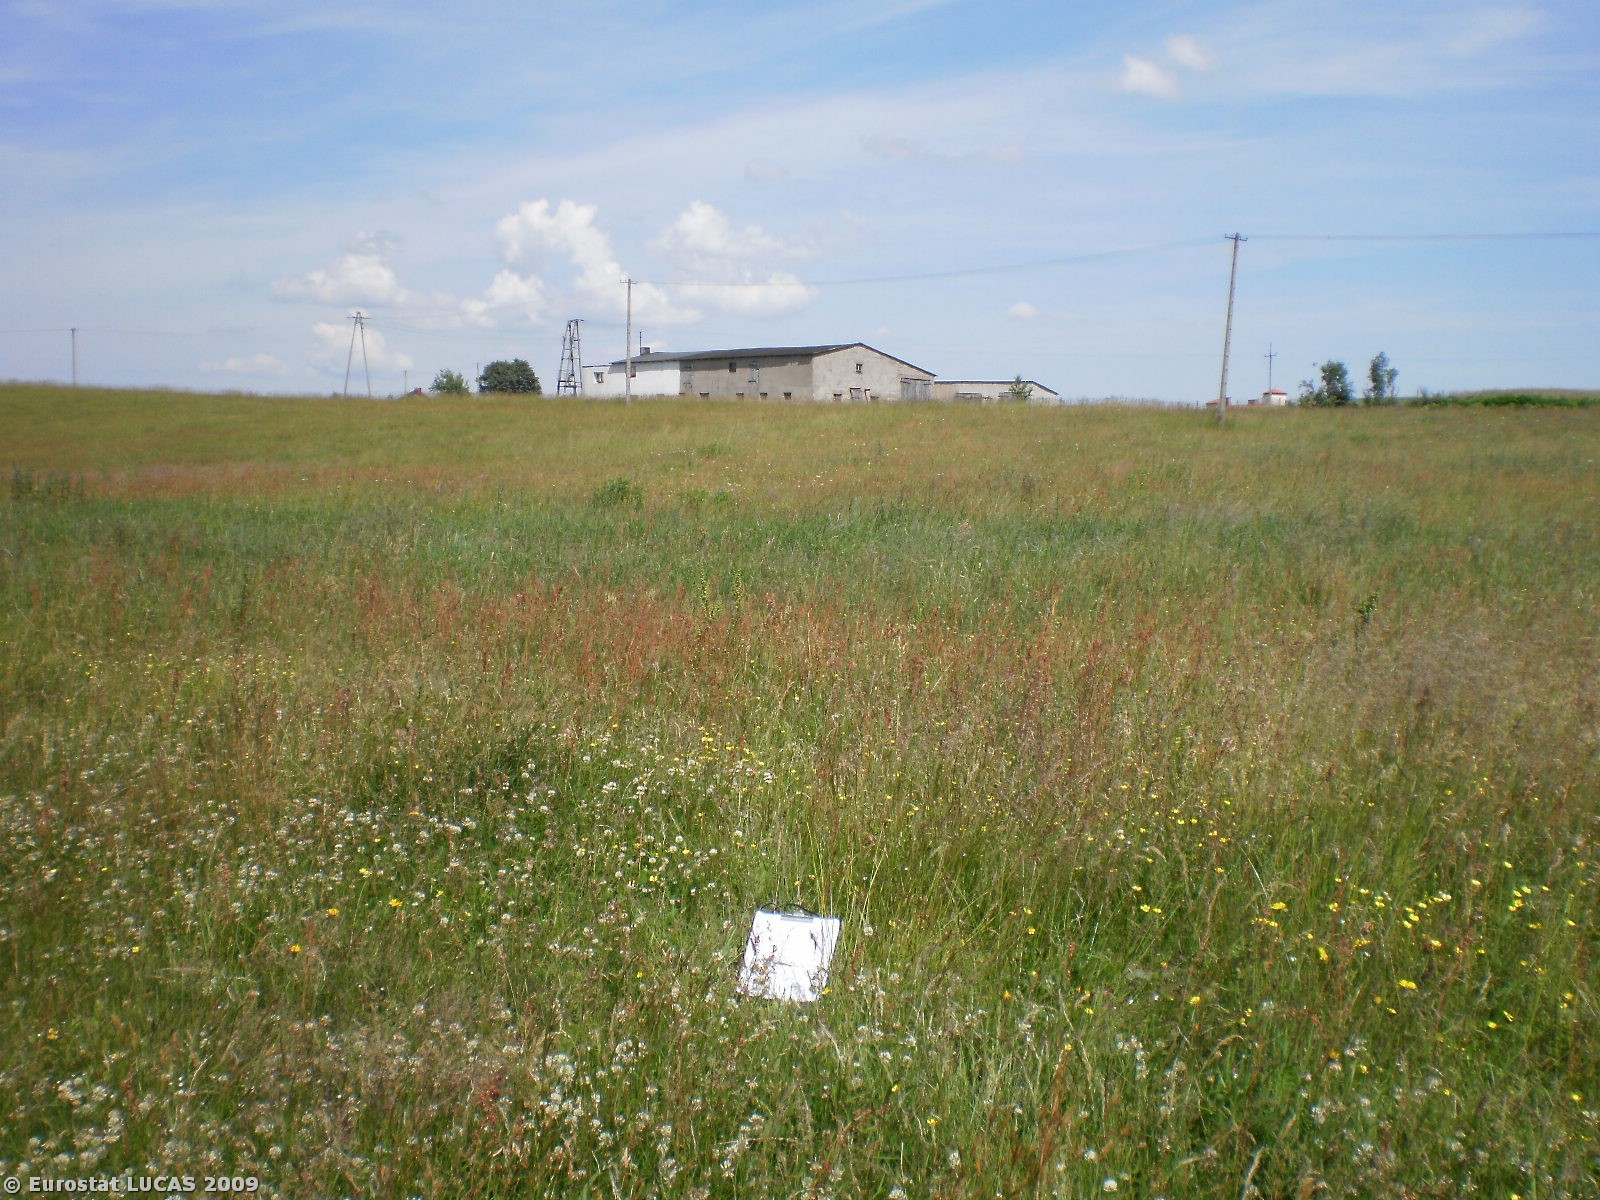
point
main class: Grassland
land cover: Grassland without tree/shrub cover
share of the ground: > 75 %
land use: Agriculture (excluding fallow land and kitchen gardens)
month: July
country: PL
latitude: 54.3160
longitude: 17.9301
